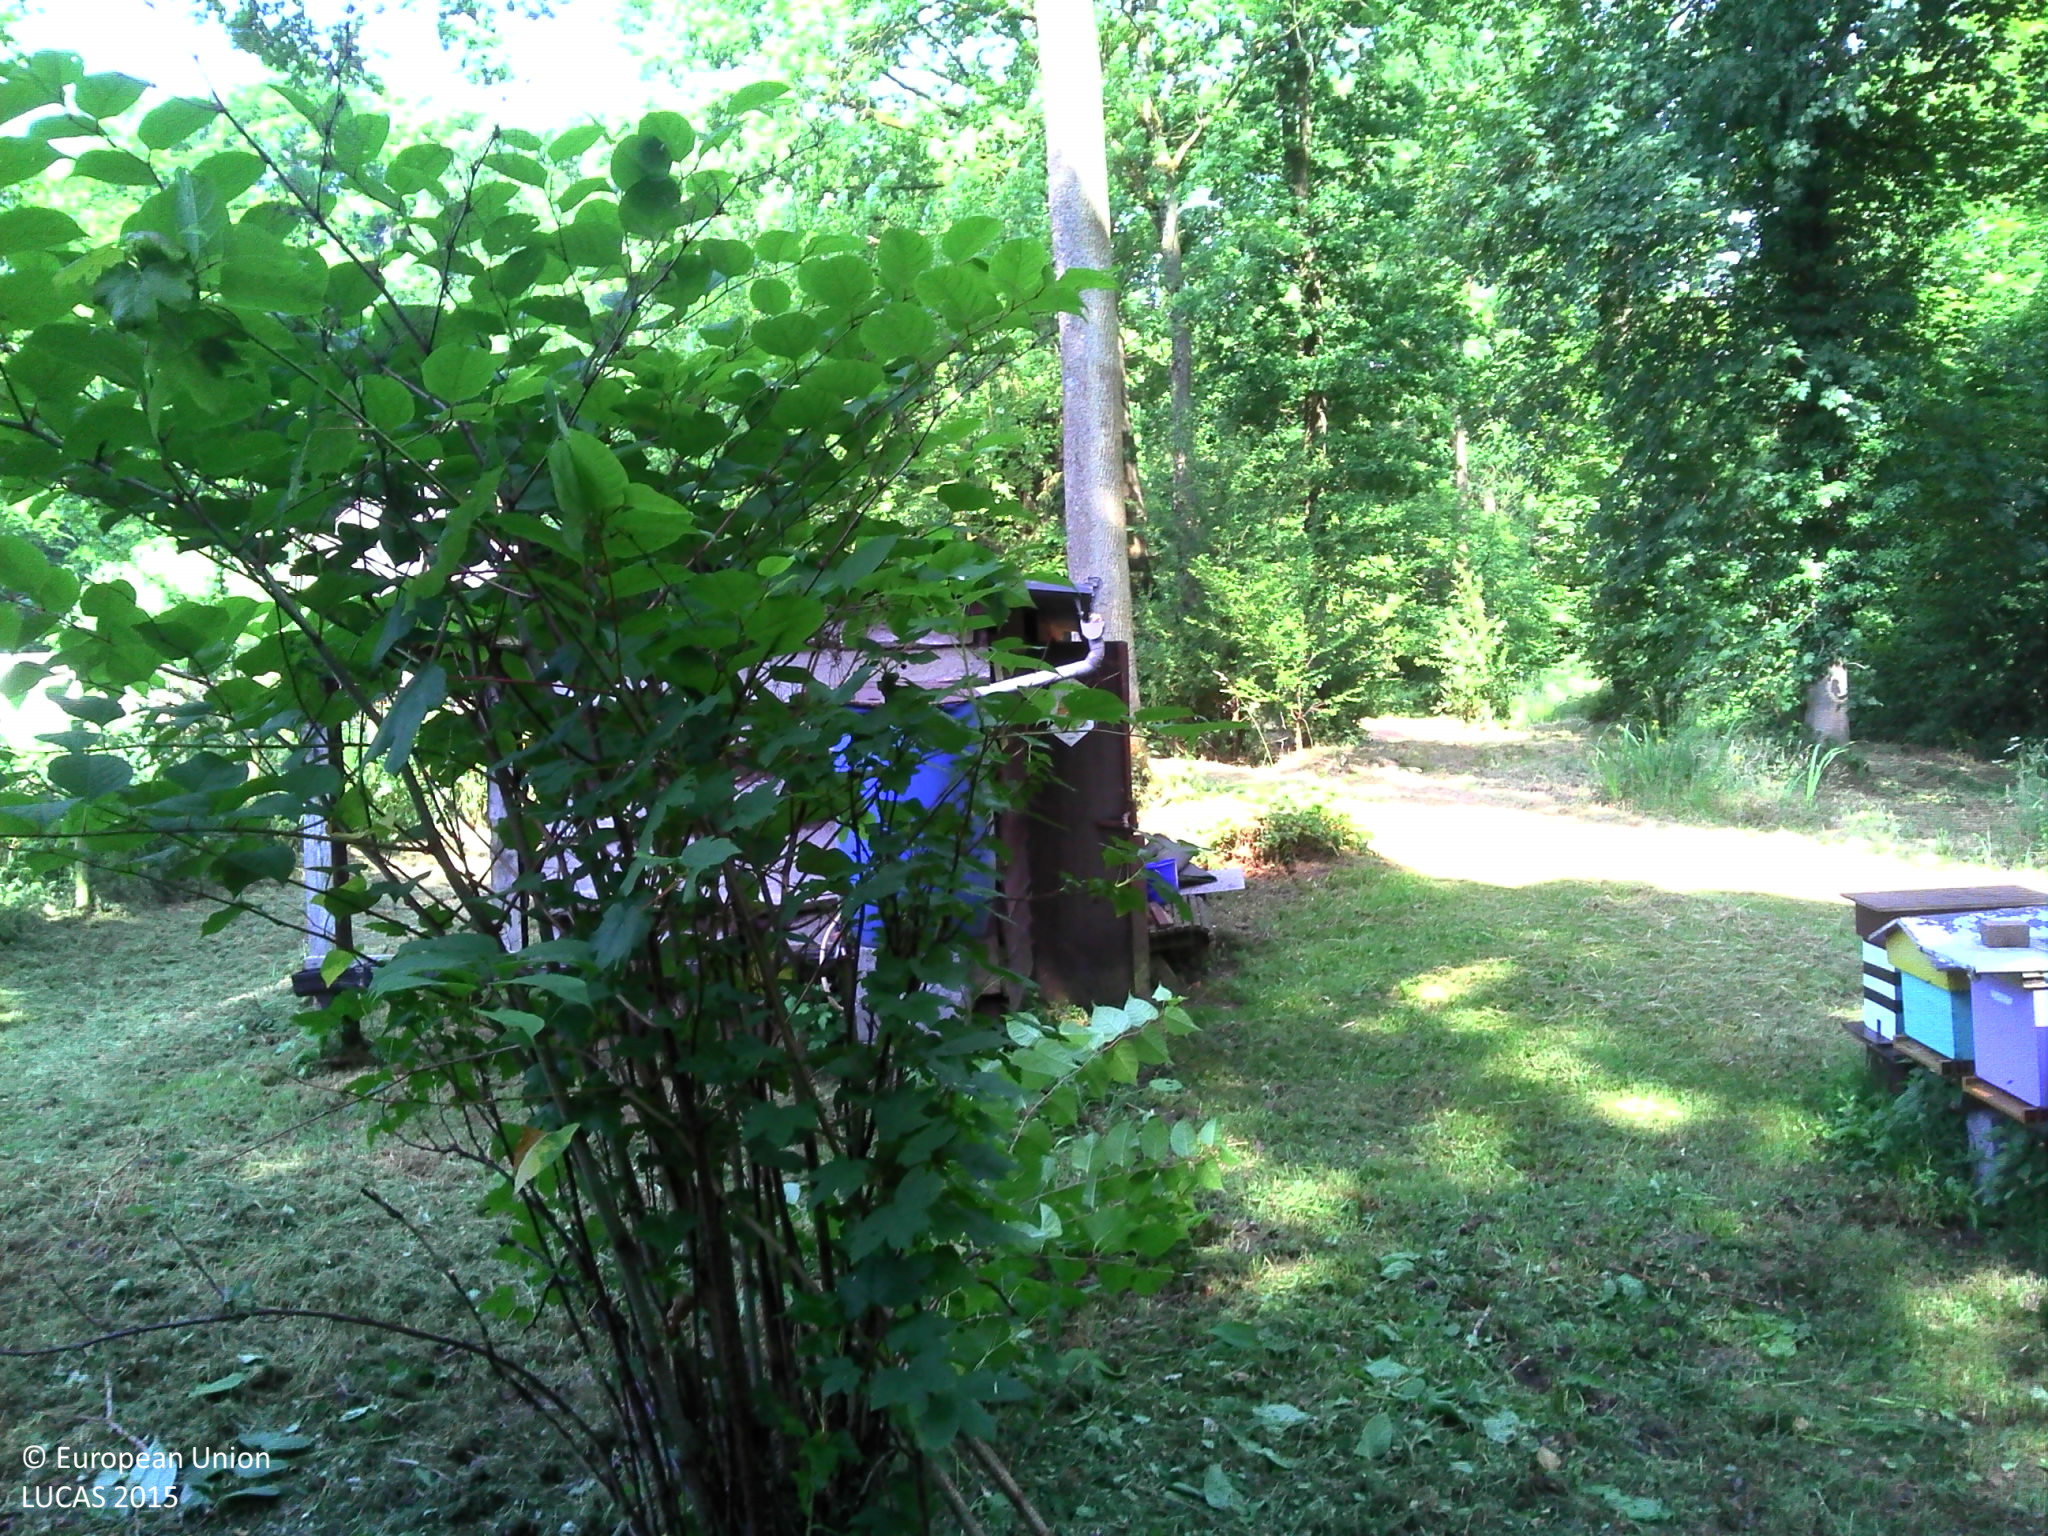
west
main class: Woodland
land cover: Broadleaved woodland
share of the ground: > 75 %
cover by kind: broadleaved forest trees 75 %, herbaceous plants 25 %
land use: Agriculture (excluding fallow land and kitchen gardens)
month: June
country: BE
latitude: 50.5175
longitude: 3.7454
